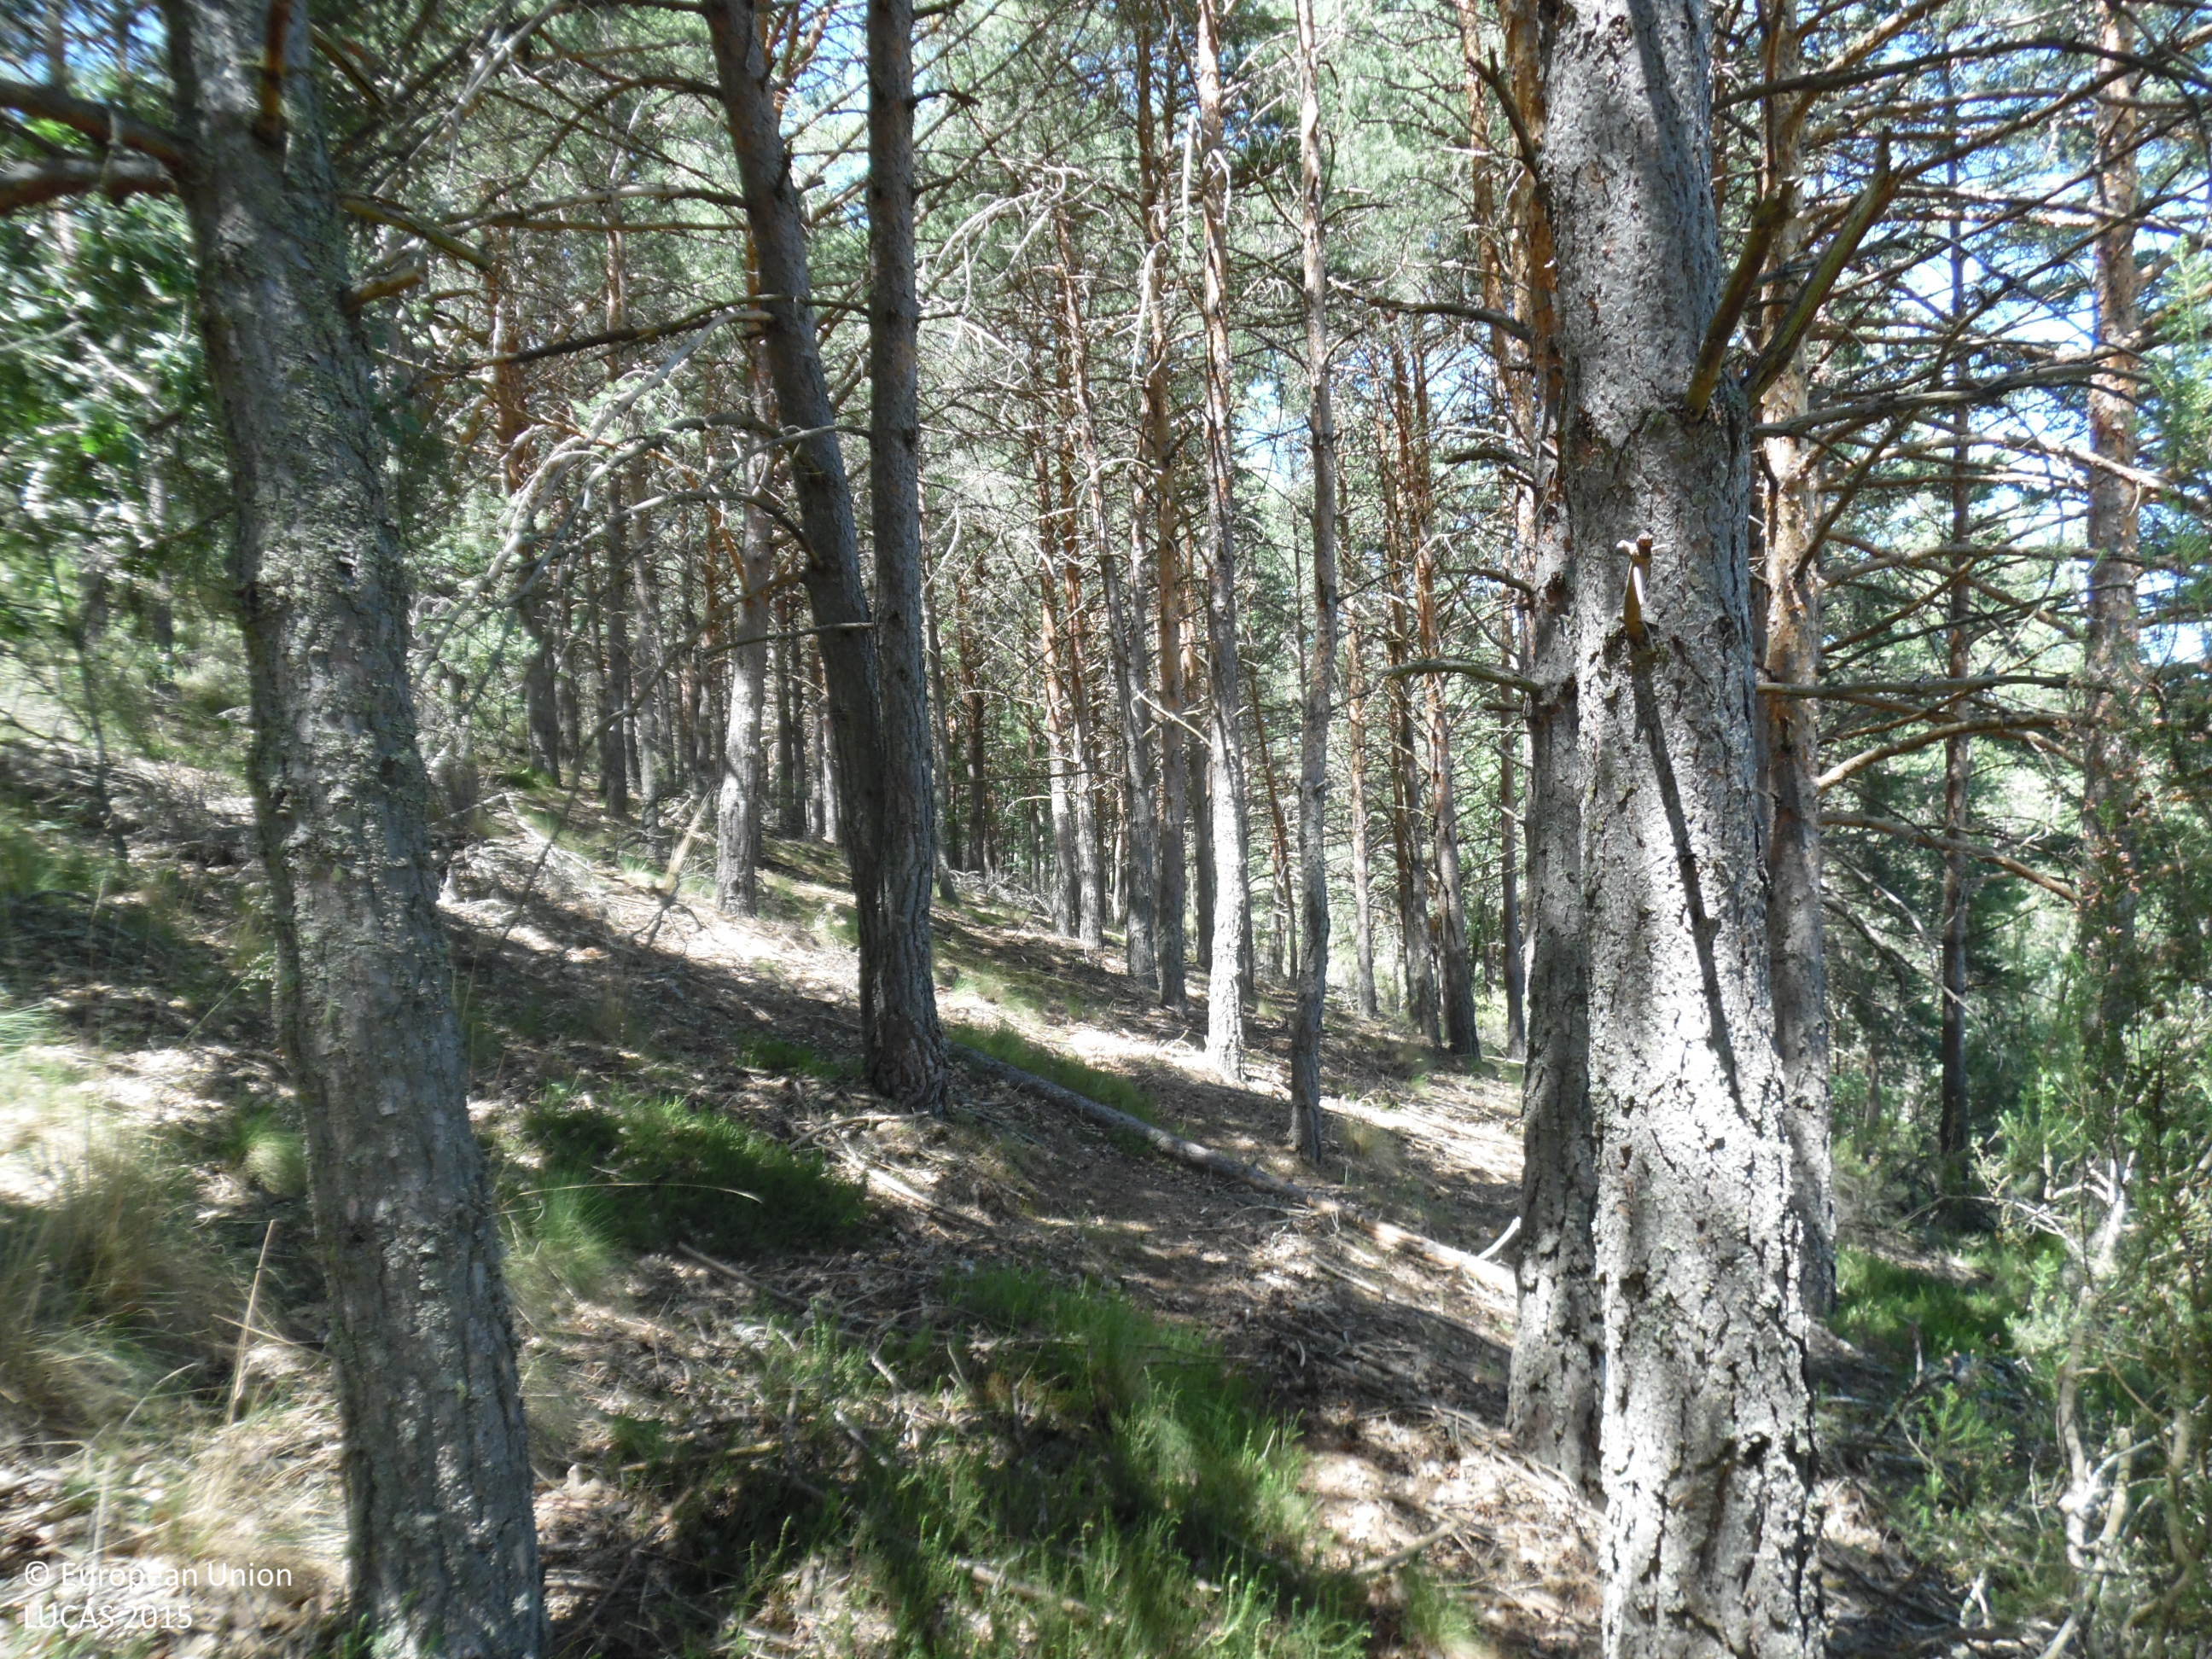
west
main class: Woodland
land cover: Pine dominated coniferous woodland
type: coniferous forest of the mediterranean region
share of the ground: 50 - 75 %
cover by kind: coniferous forest trees 95 %, shrubs 5 %
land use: Forestry
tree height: > 5 m
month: June
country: ES
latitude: 42.5433
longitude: -6.1460
